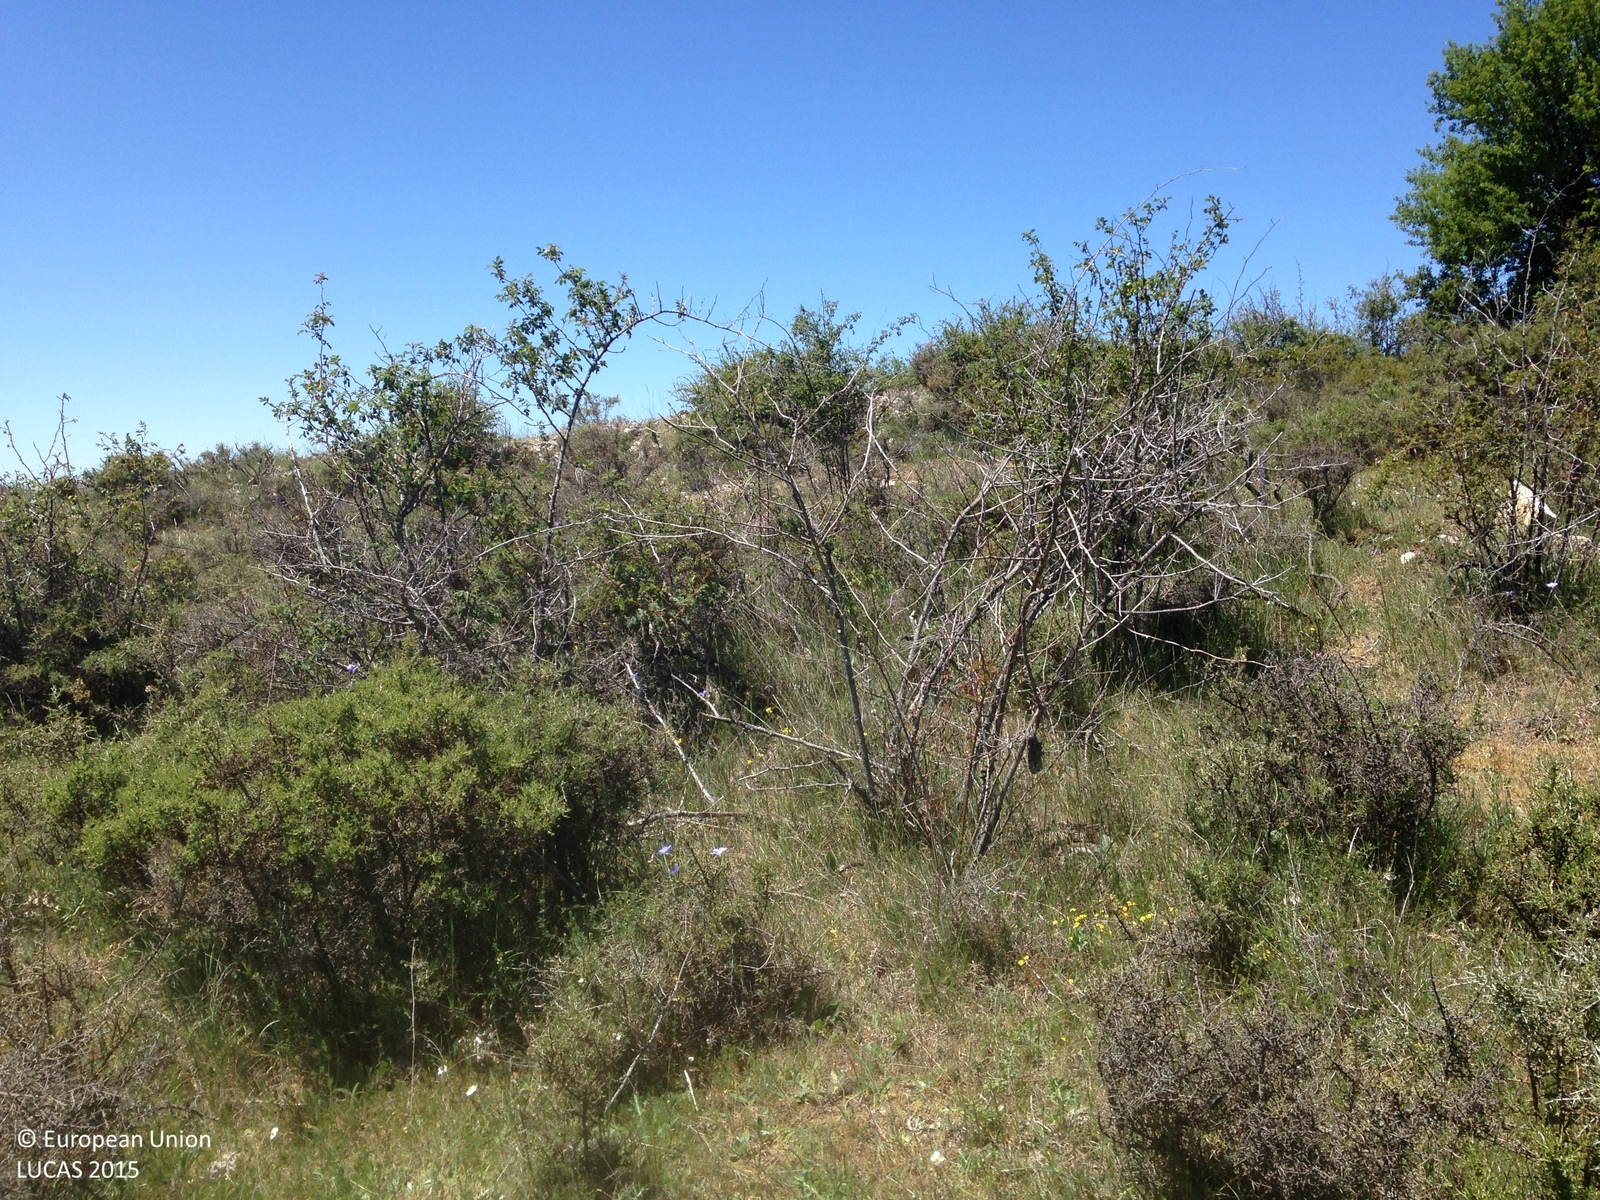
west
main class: Shrubland
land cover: Shrubland without tree cover
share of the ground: 50 - 75 %
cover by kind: shrubs 65 %, herbaceous plants 20 %, consolidated bare surface 15 %
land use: Semi-natural and natural areas not in use
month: May
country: ES
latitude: 40.5473
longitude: -2.0291
